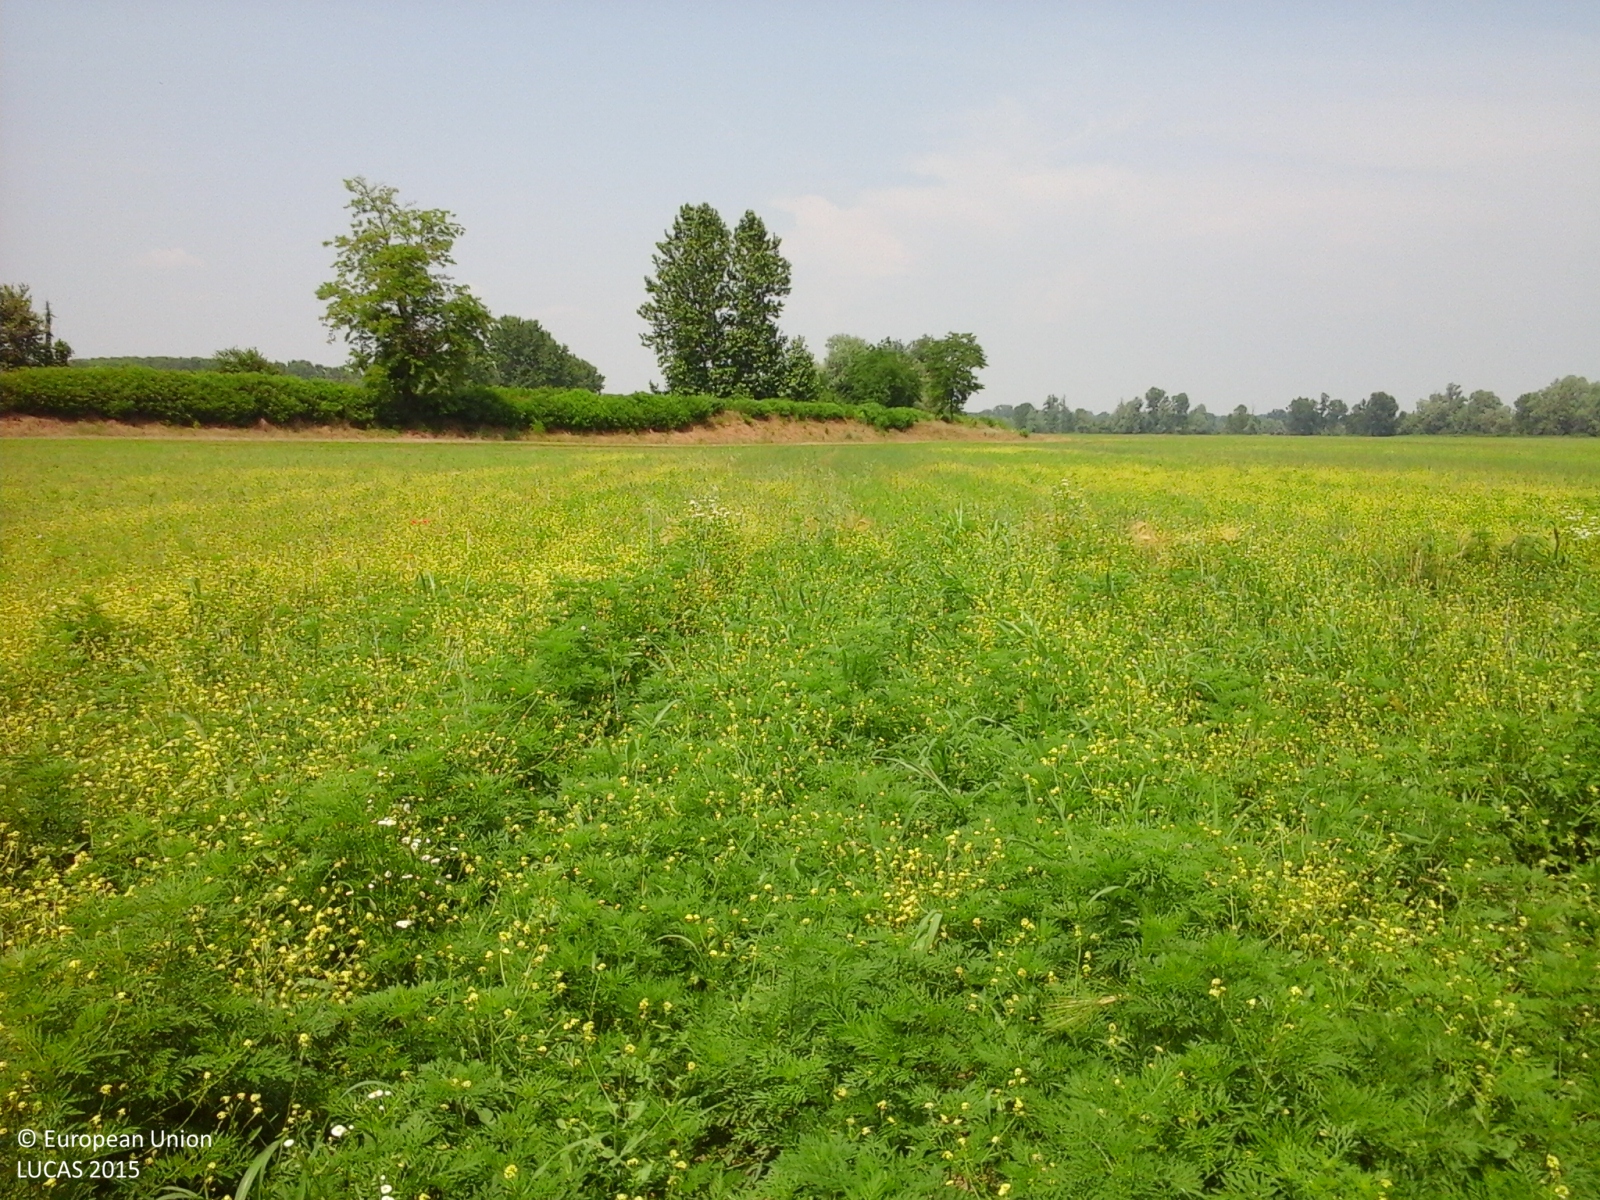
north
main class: Grassland
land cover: Spontaneously vegetated surfaces
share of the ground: > 75 %
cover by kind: herbaceous plants 100 %
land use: Agriculture (excluding fallow land and kitchen gardens)
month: June
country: IT
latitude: 45.2695
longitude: 9.6565
